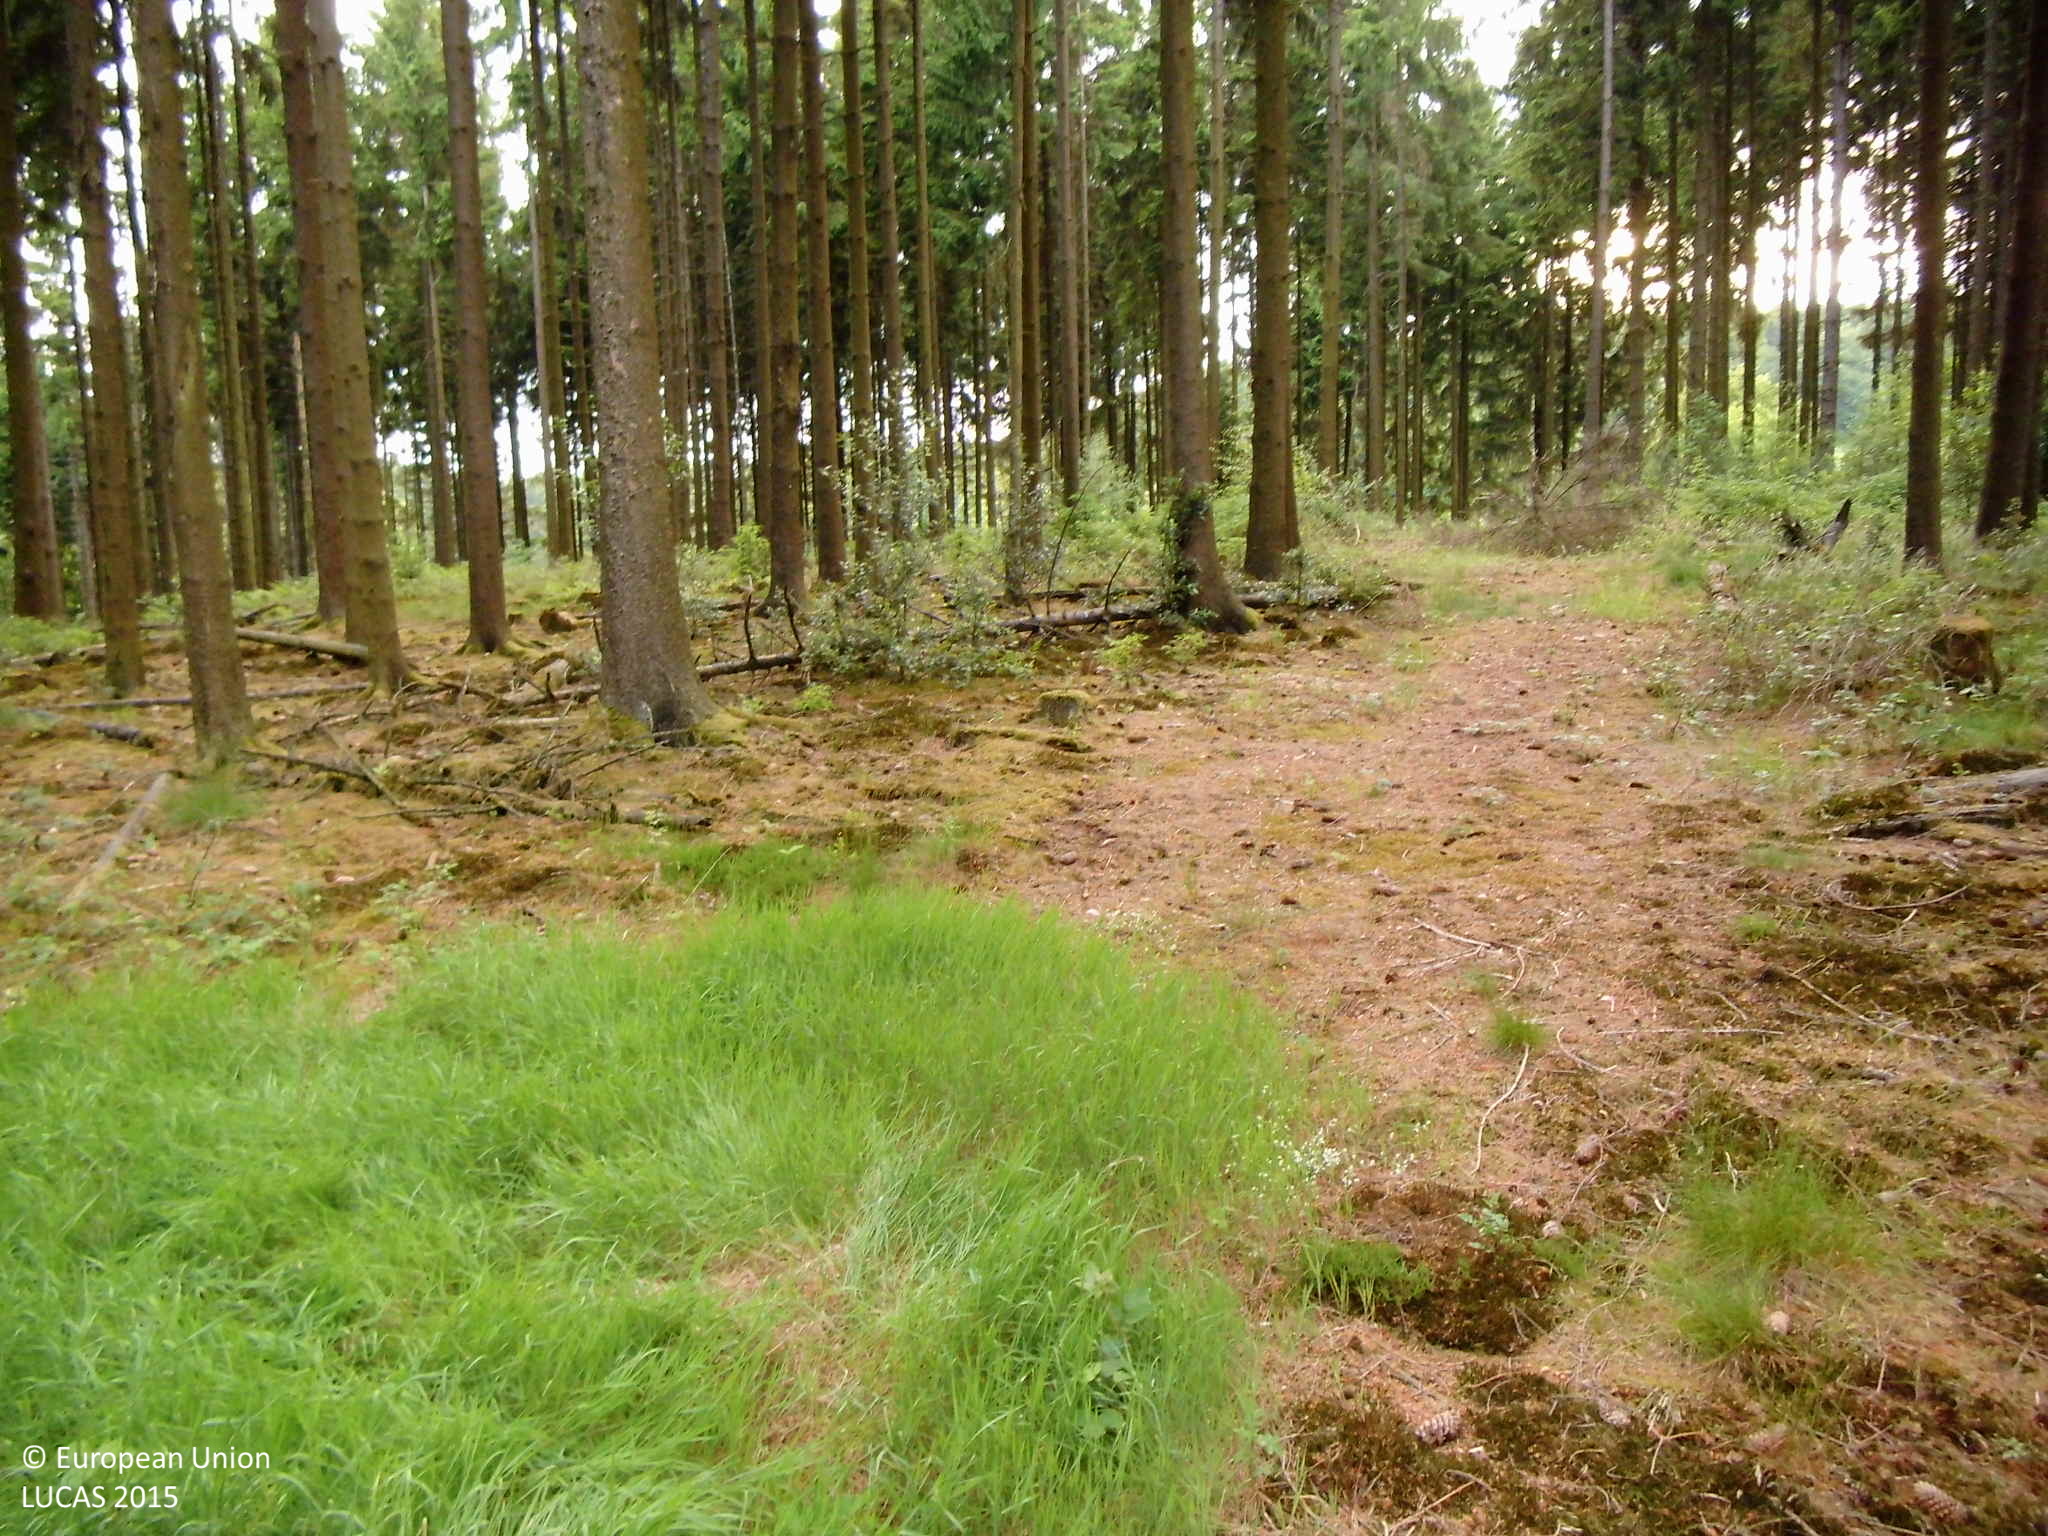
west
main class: Woodland
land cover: Spruce dominated coniferous woodland
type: hemiboreal forest and nemoral coniferous forest and mixed broadleaved-coniferous forest
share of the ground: 25 - 50 %
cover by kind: coniferous forest trees 45 %, lichens and mosses 20 %, shrubs 15 %, herbaceous plants 15 %, unconsolidated bare surface 5 %
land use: Forestry
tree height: > 5 m
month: June
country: DE
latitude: 51.2180
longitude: 7.4947
